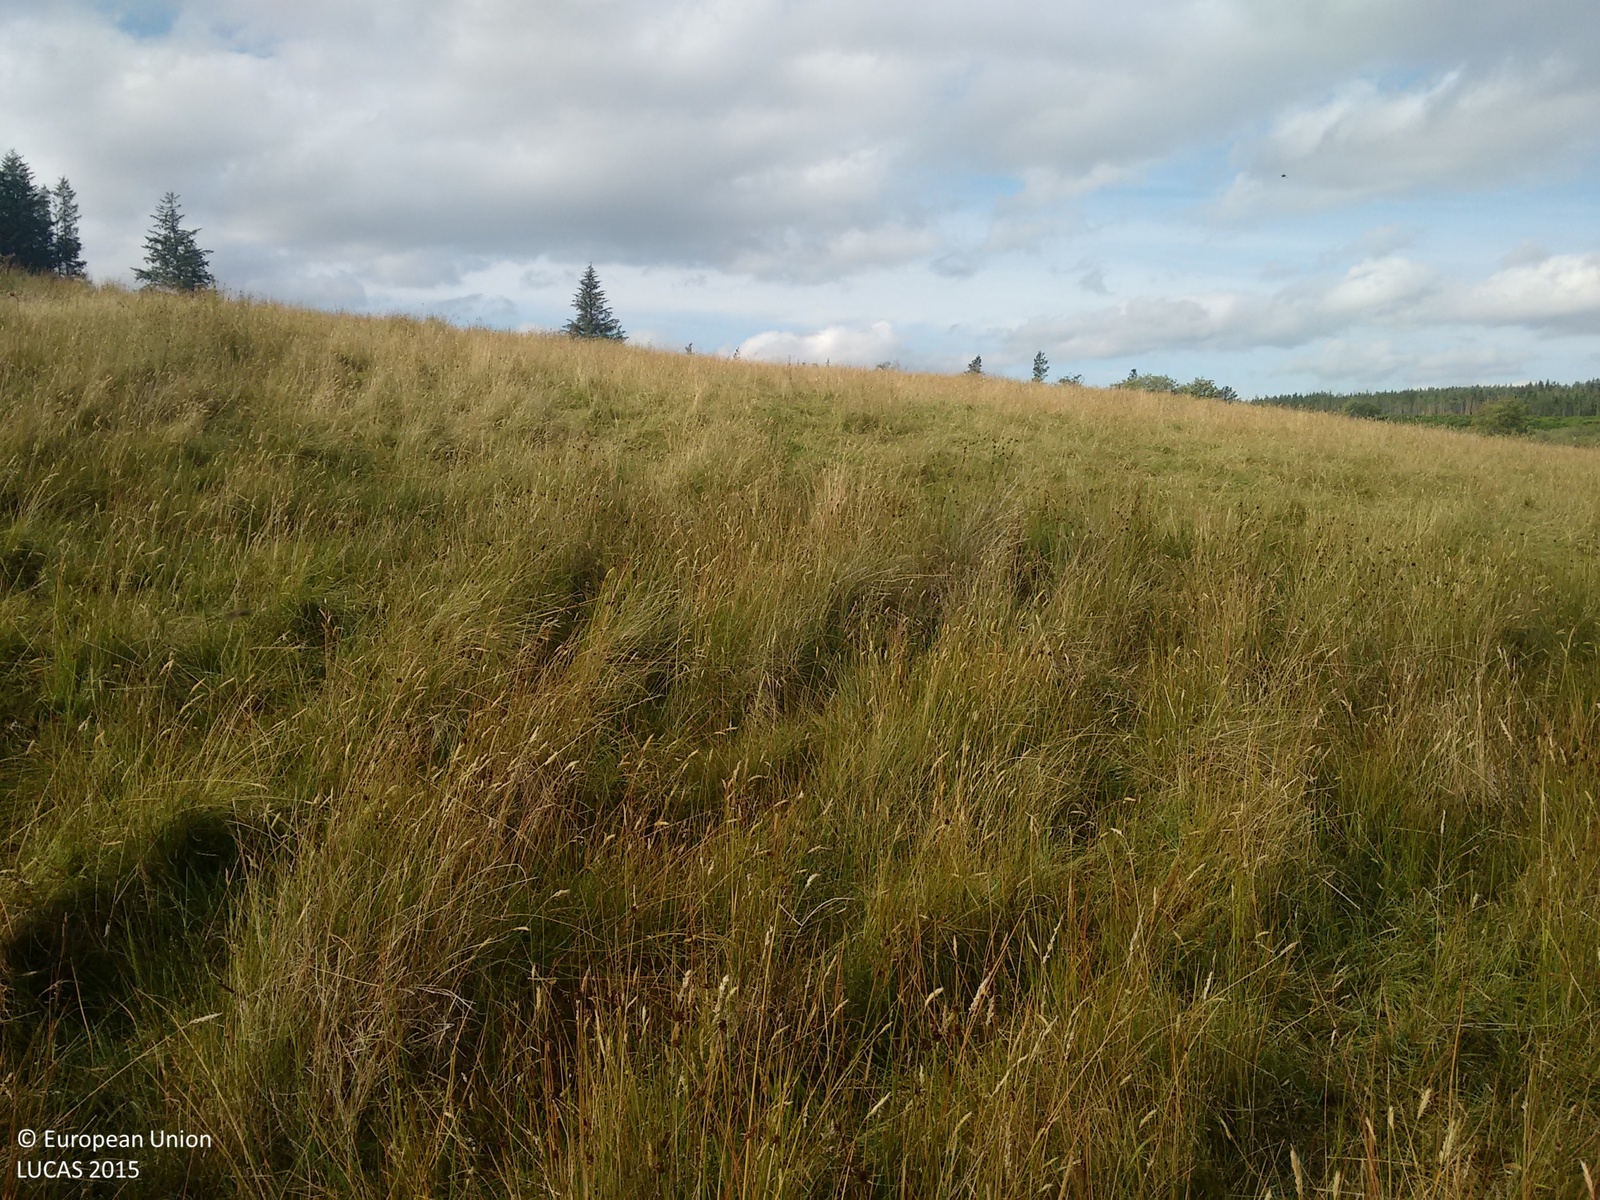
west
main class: Grassland
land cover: Grassland without tree/shrub cover
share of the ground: > 75 %
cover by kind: herbaceous plants 100 %
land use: Agriculture (excluding fallow land and kitchen gardens)
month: September
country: GB
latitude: 57.9127
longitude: -4.4164
